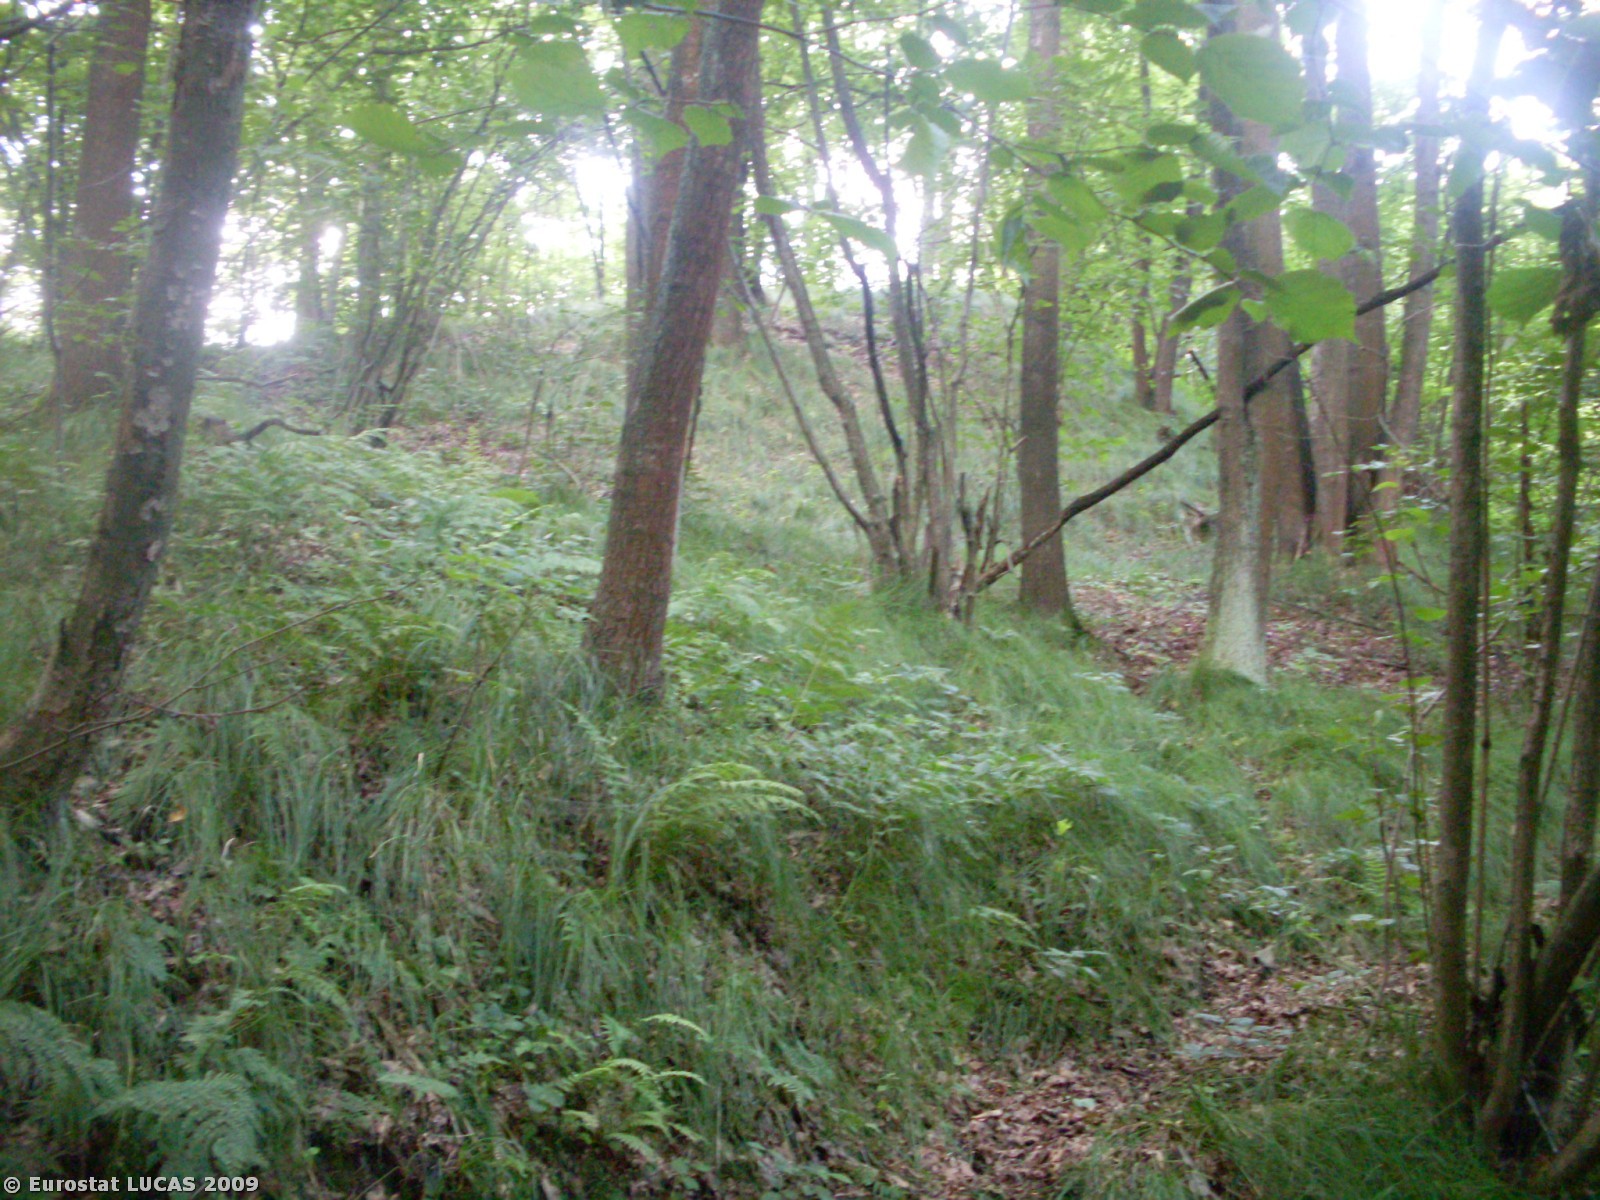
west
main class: Woodland
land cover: Broadleaved woodland
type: mesophytic deciduous forest
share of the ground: > 75 %
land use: Unused
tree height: > 5 m
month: July
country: PL
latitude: 49.9279
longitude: 19.9639
